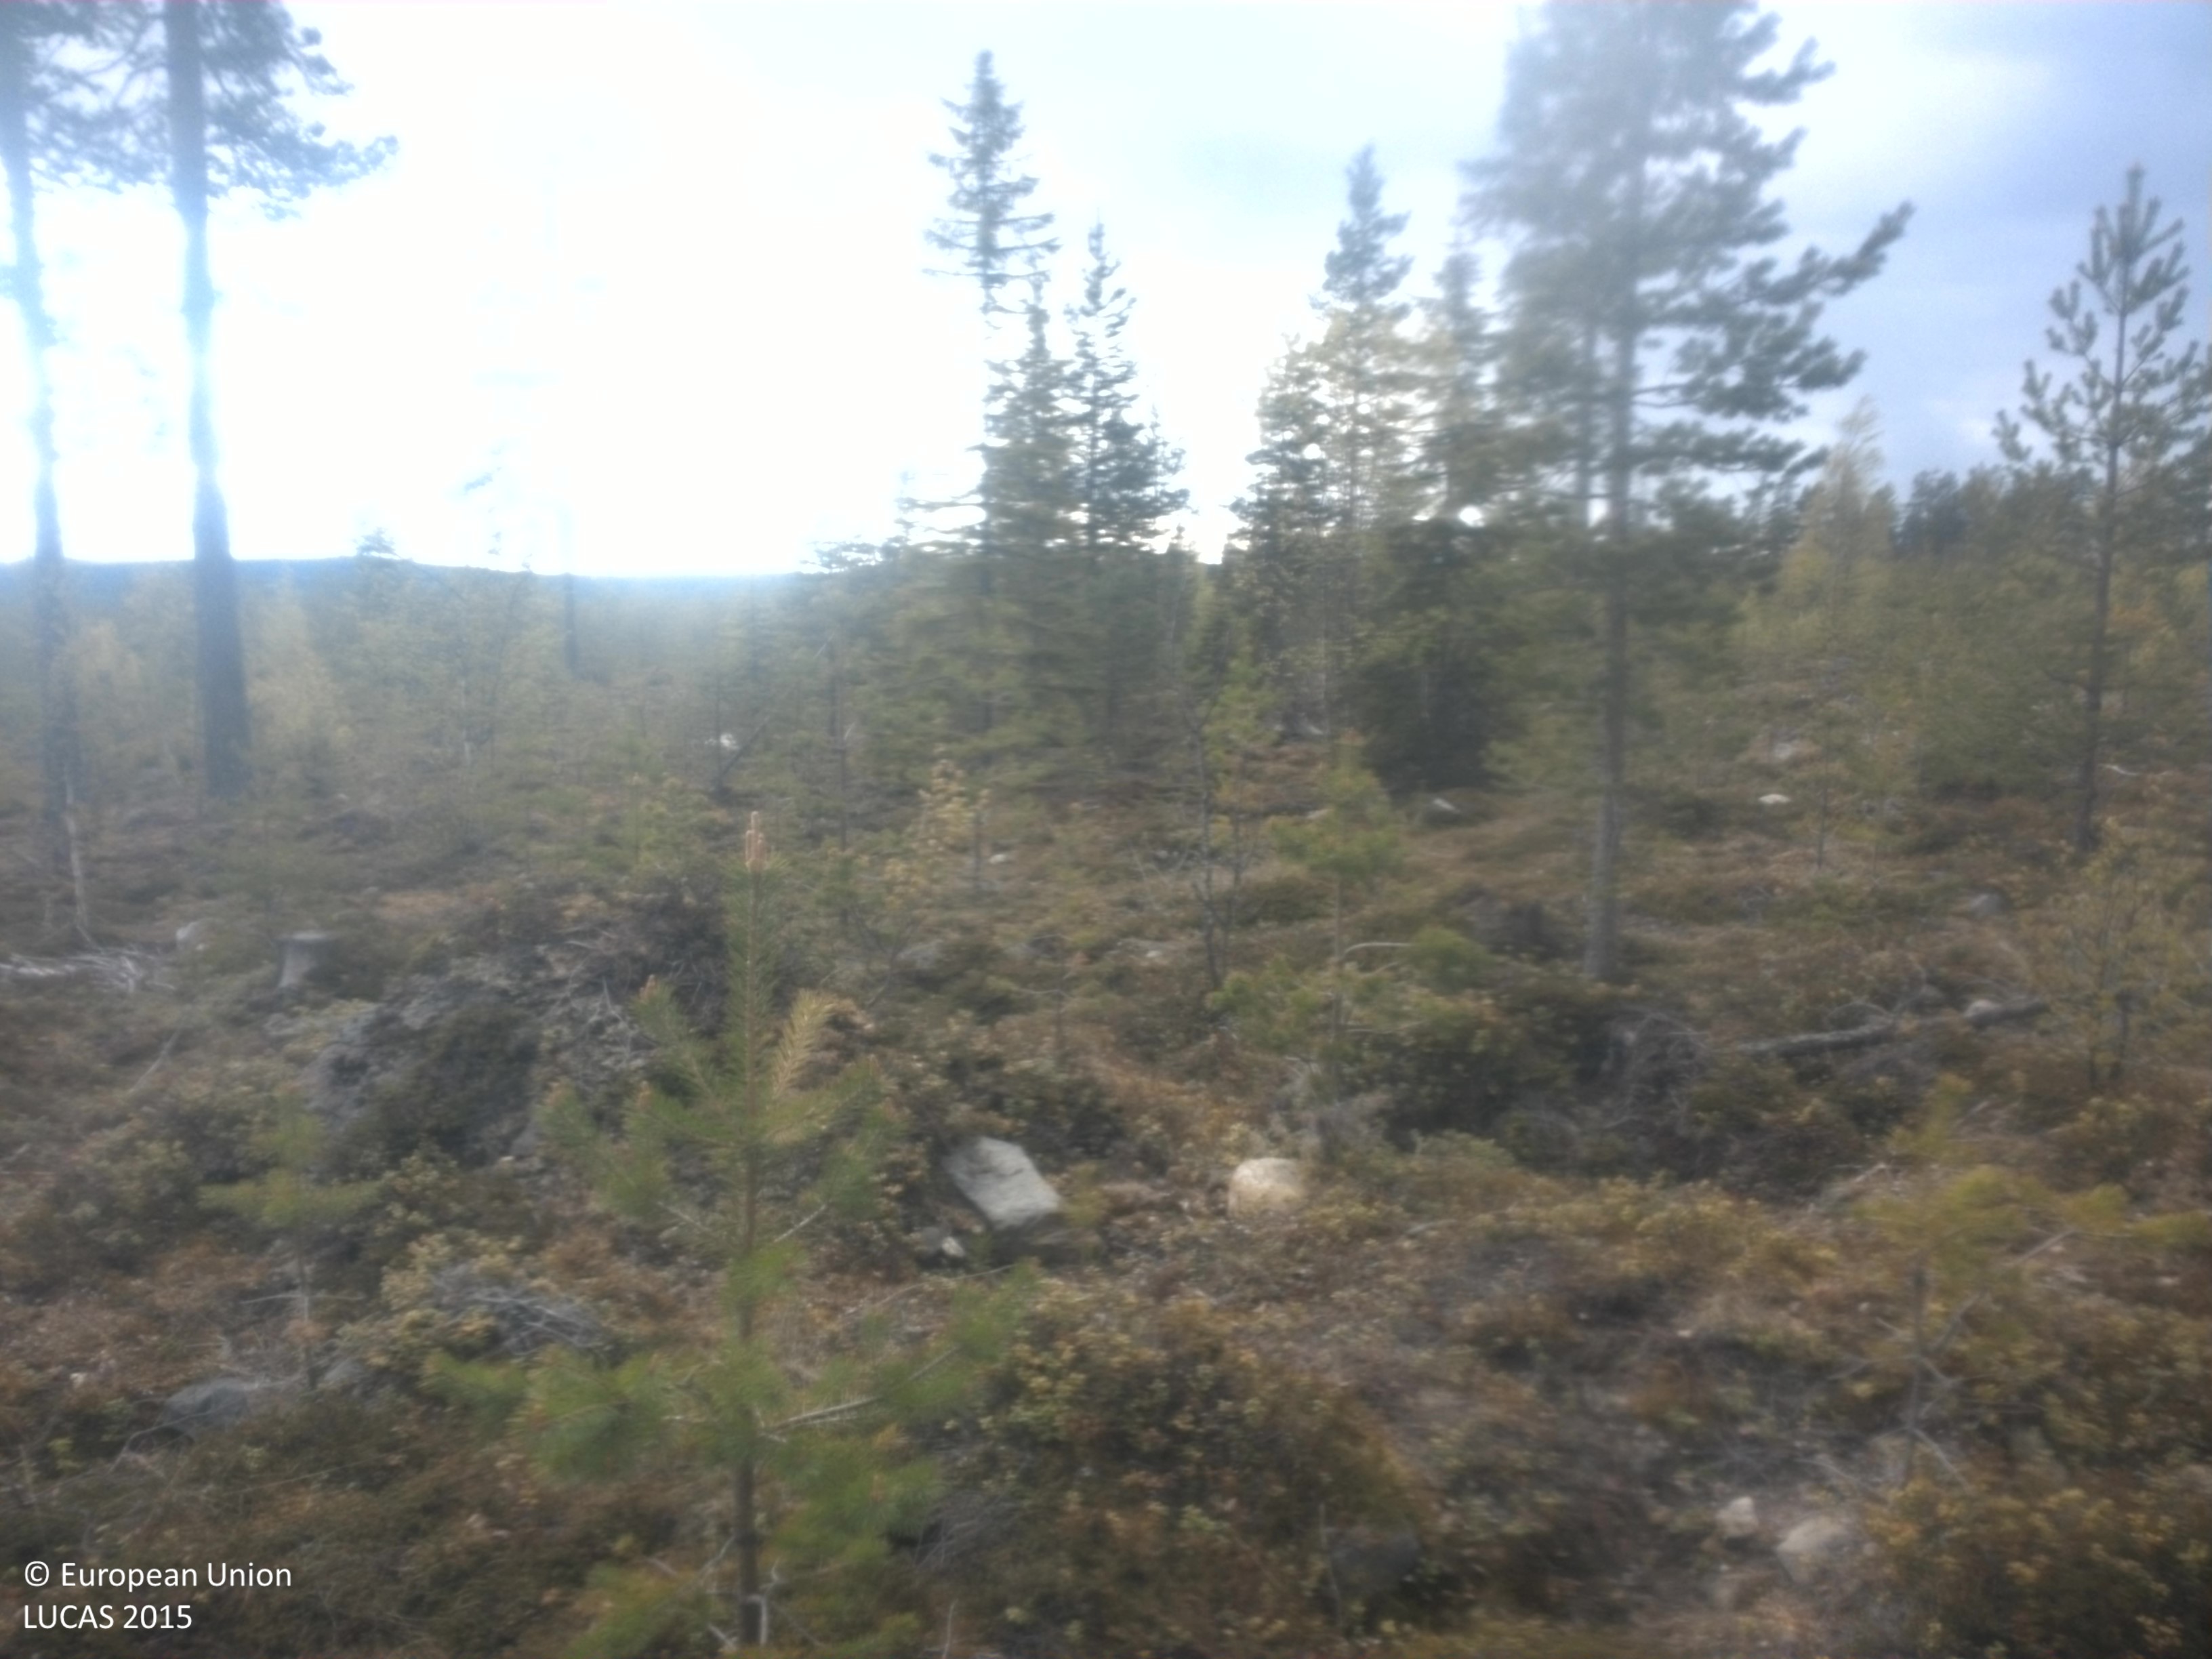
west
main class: Woodland
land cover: Pine dominated coniferous woodland
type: boreal forest
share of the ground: 10 - 25 %
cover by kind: herbaceous plants 35 %, lichens and mosses 25 %, coniferous forest trees 20 %, unconsolidated bare surface 10 %, broadleaved forest trees 5 %, shrubs 5 %
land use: Forestry
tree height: < 5 m
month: June
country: SE
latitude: 64.3746
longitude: 17.6981
